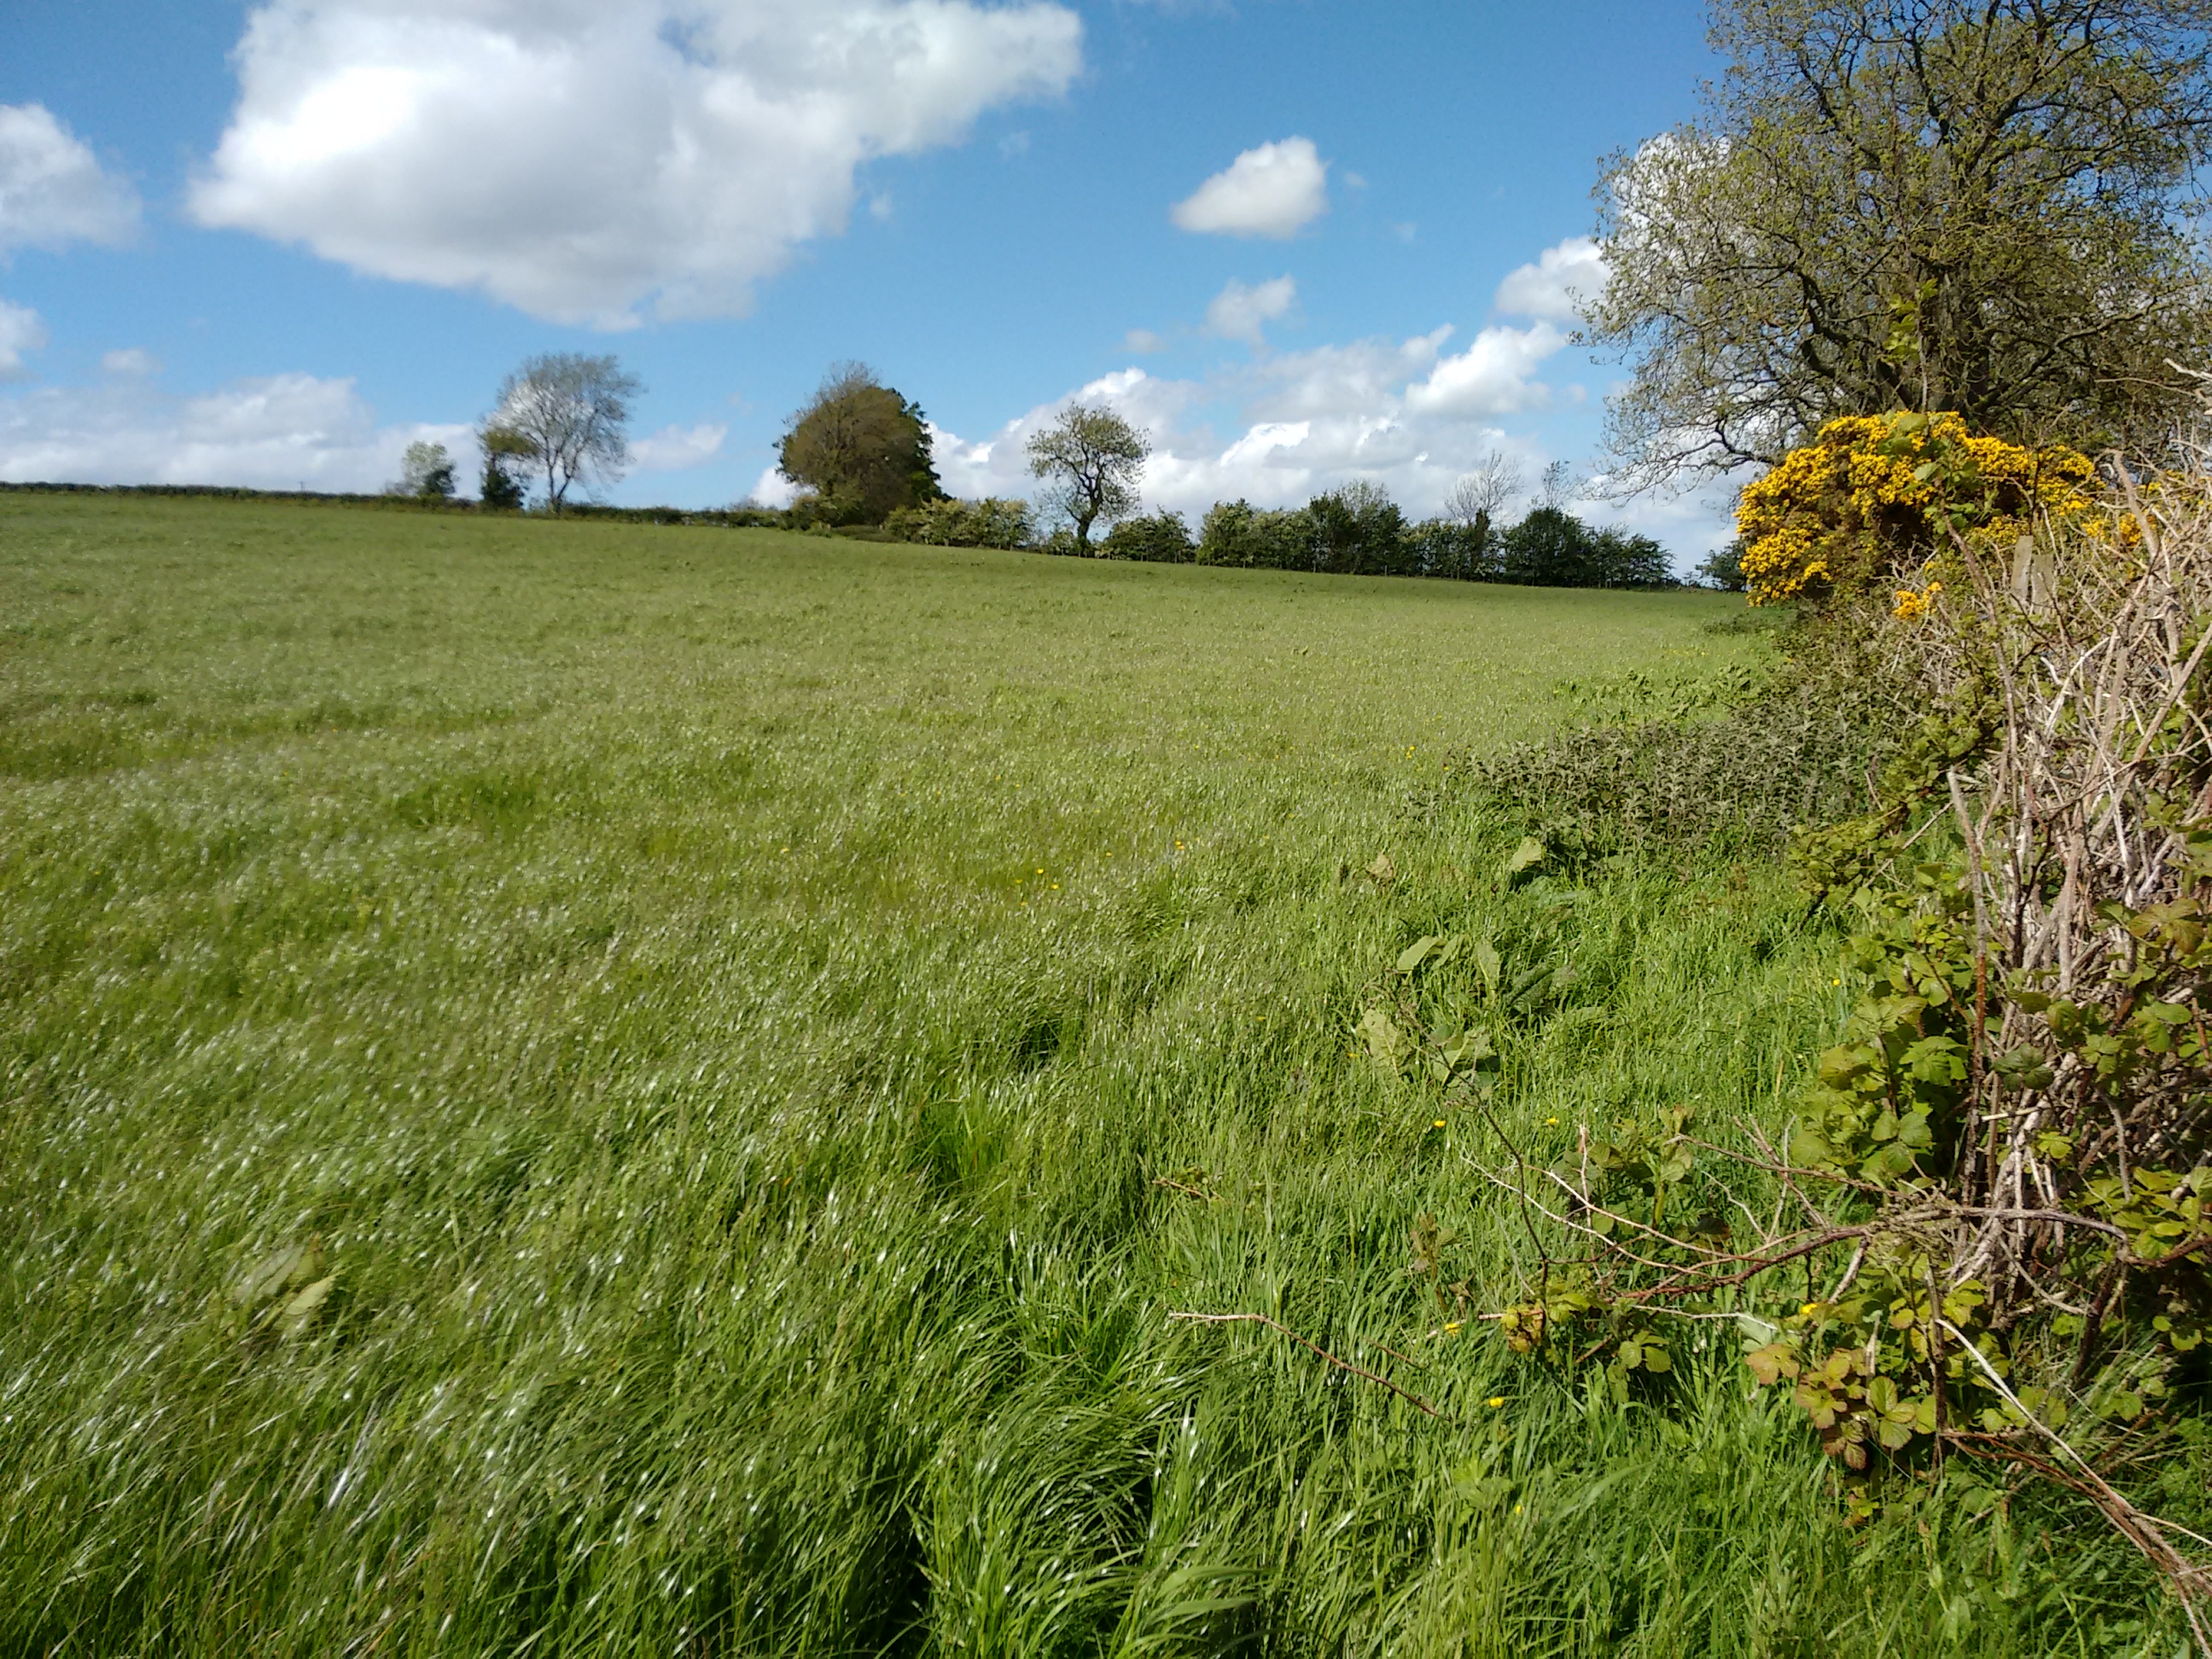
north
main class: Grassland
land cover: Grassland without tree/shrub cover
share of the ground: > 75 %
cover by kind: herbaceous plants 100 %
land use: Agriculture (excluding fallow land and kitchen gardens)
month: June
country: GB
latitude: 54.9114
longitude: -7.0003
